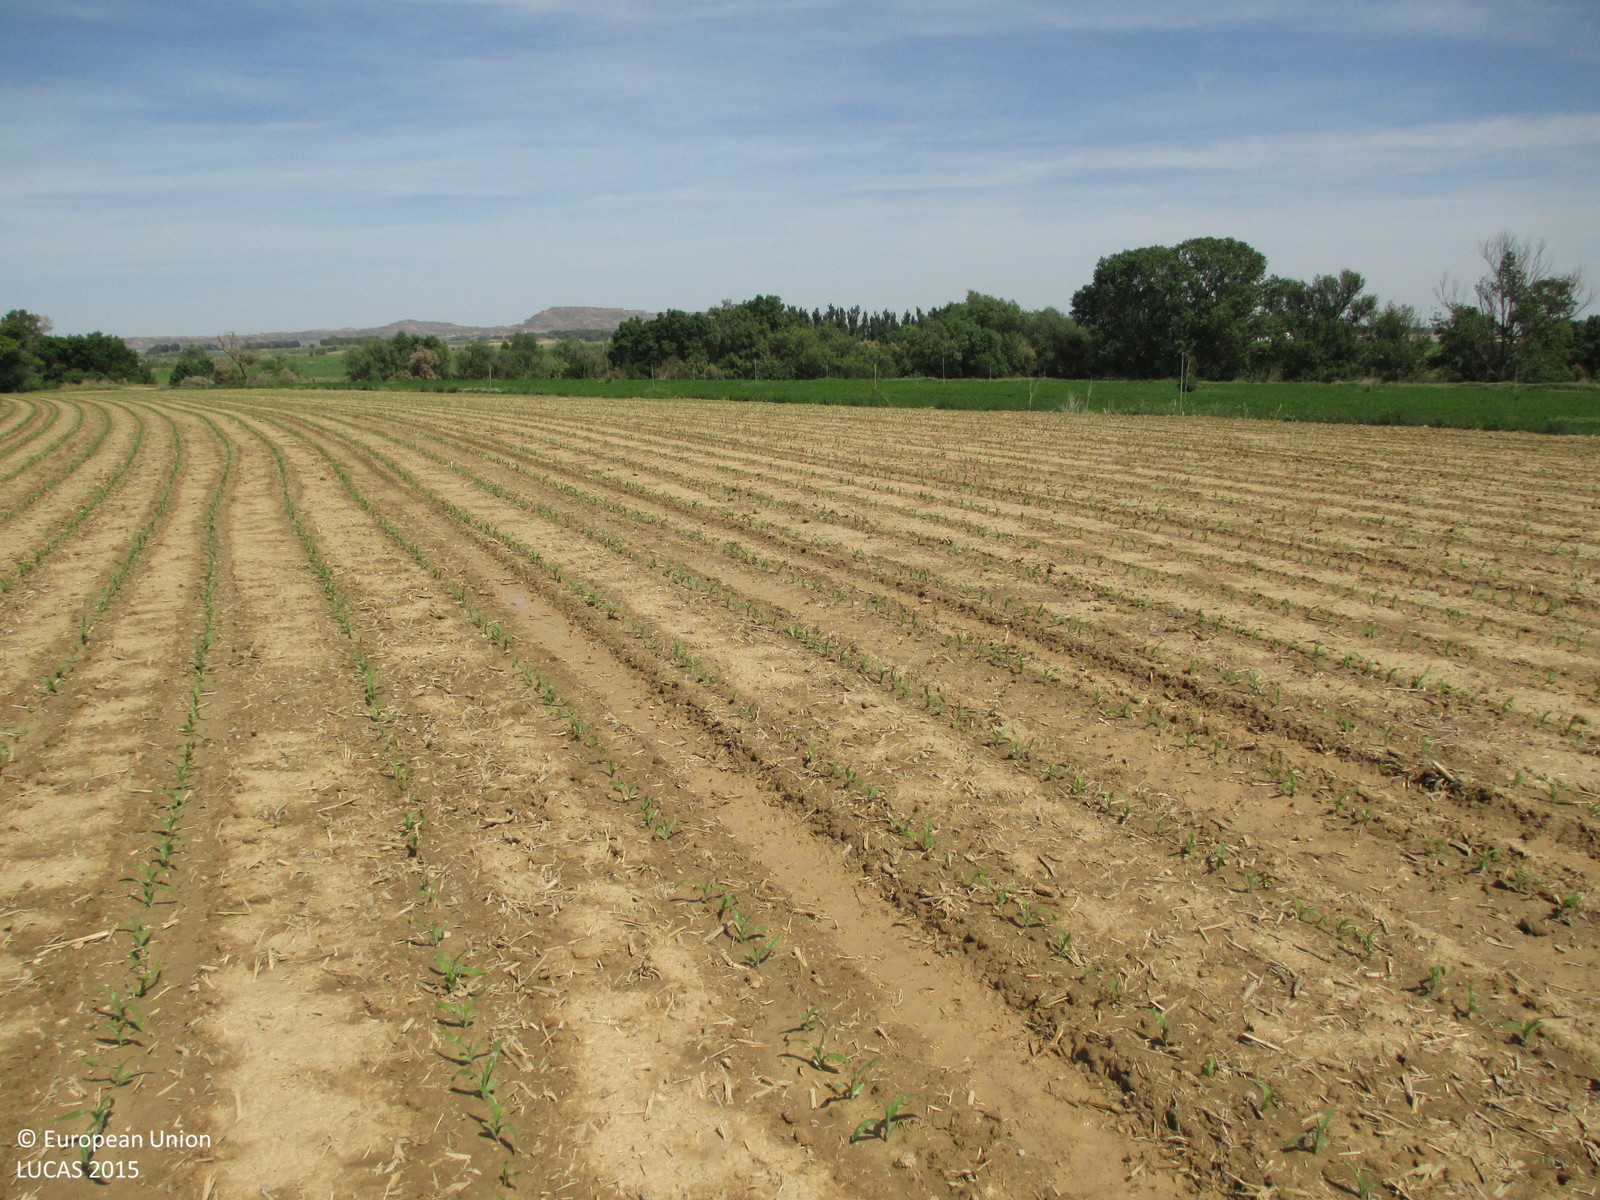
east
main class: Cropland
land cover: Maize
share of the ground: 10 - 25 %
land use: Agriculture (excluding fallow land and kitchen gardens)
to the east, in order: Maize; Lucerne; Grass margins; Tracks; Shrubland with sparse tree cover; Broadleaved woodland; Shrubland without tree cover; Lucerne
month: May
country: ES
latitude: 41.9218
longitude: -0.3541
